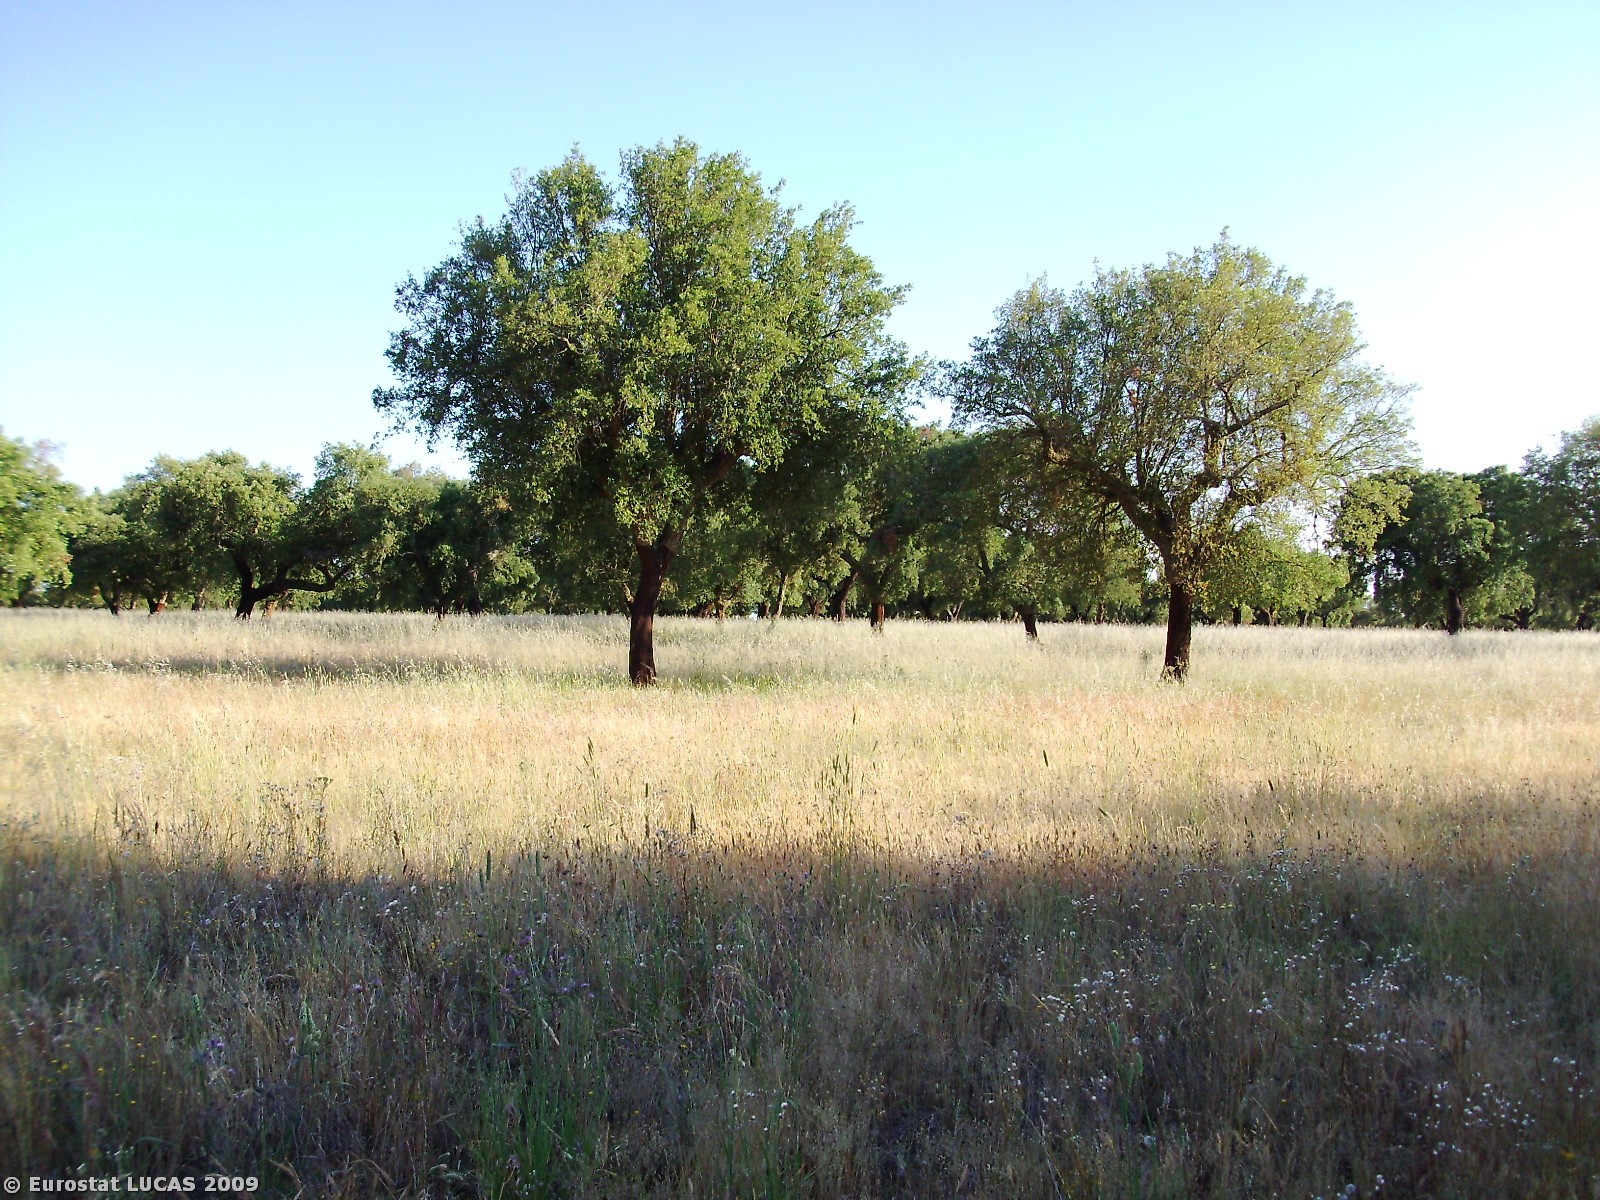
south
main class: Woodland
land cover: Broadleaved woodland
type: broadleaved evergreen forest
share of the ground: 10 - 25 %
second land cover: Grassland with sparse tree/shrub cover
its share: > 75 %
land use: Forestry
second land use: Agriculture (excluding fallow land and kitchen gardens)
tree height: > 5 m
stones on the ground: 25 - 50 %
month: May
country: PT
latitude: 38.9123
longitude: -7.7443
